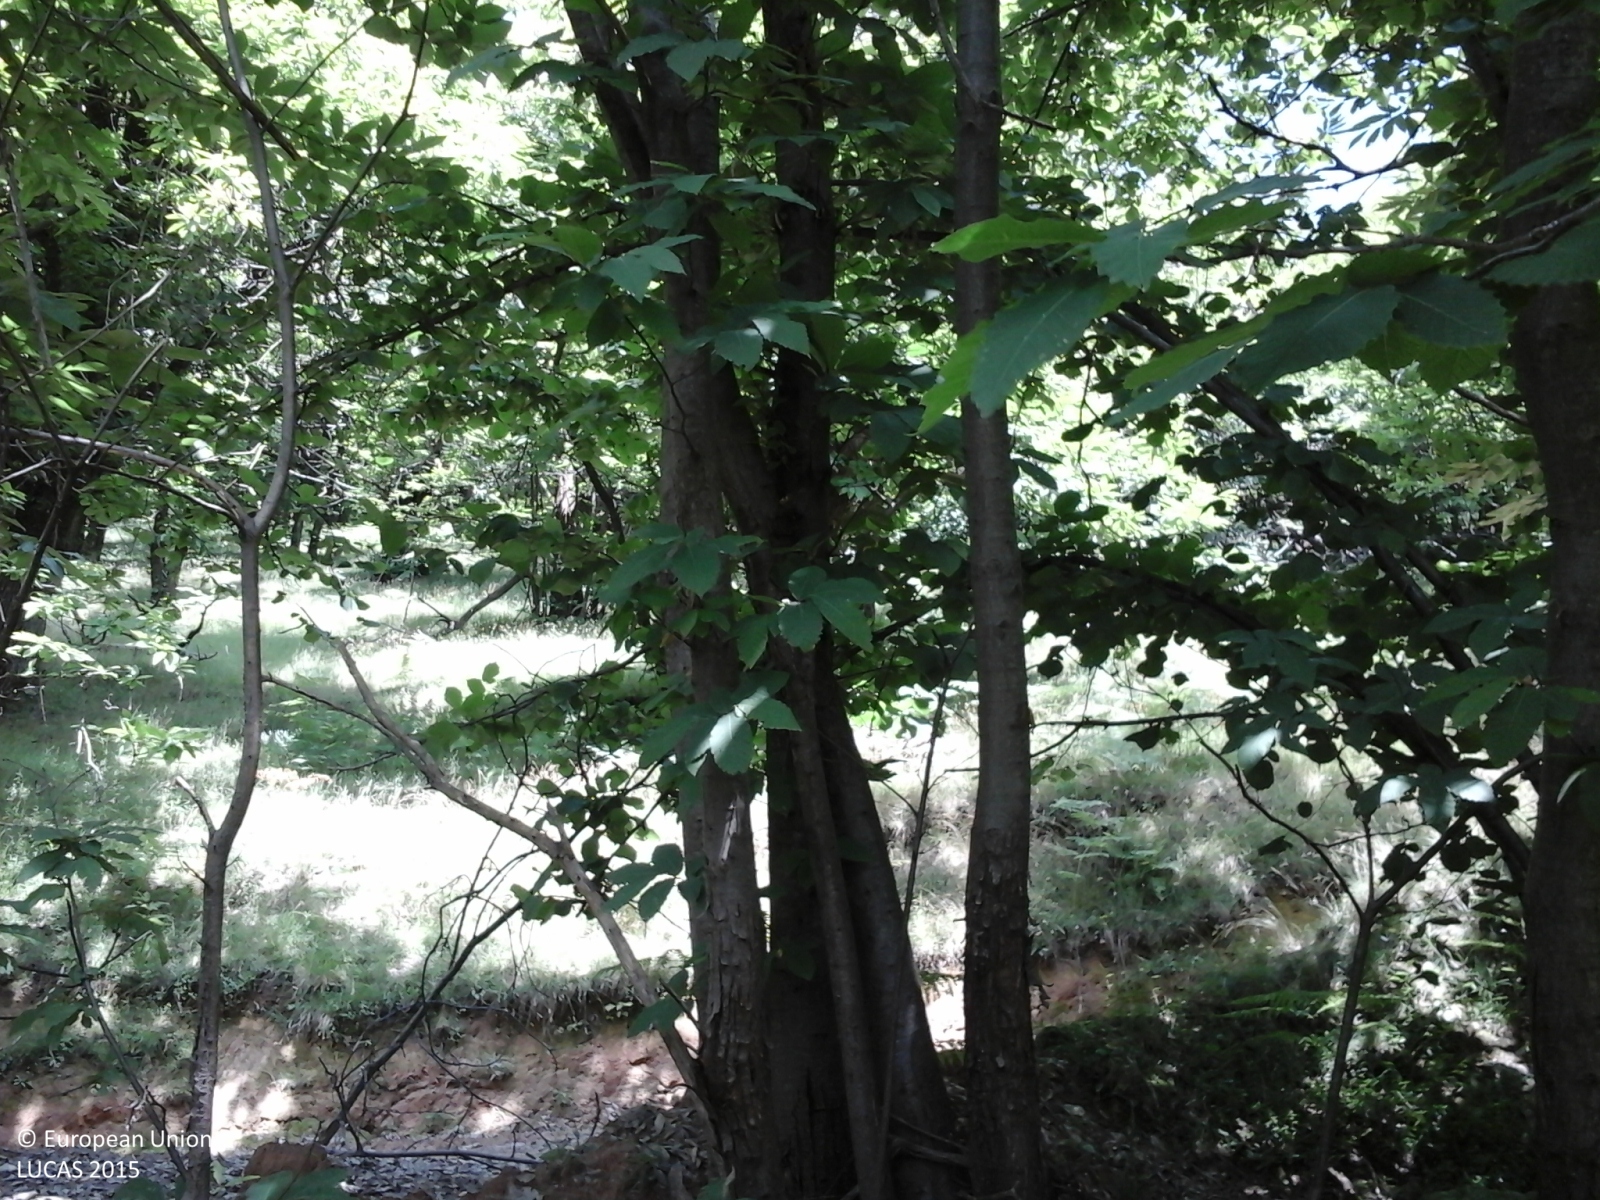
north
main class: Woodland
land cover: Broadleaved woodland
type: thermophilous deciduous forest
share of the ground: > 75 %
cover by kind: broadleaved forest trees 100 %
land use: Semi-natural and natural areas not in use
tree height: > 5 m
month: June
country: IT
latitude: 44.3084
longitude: 7.7609
